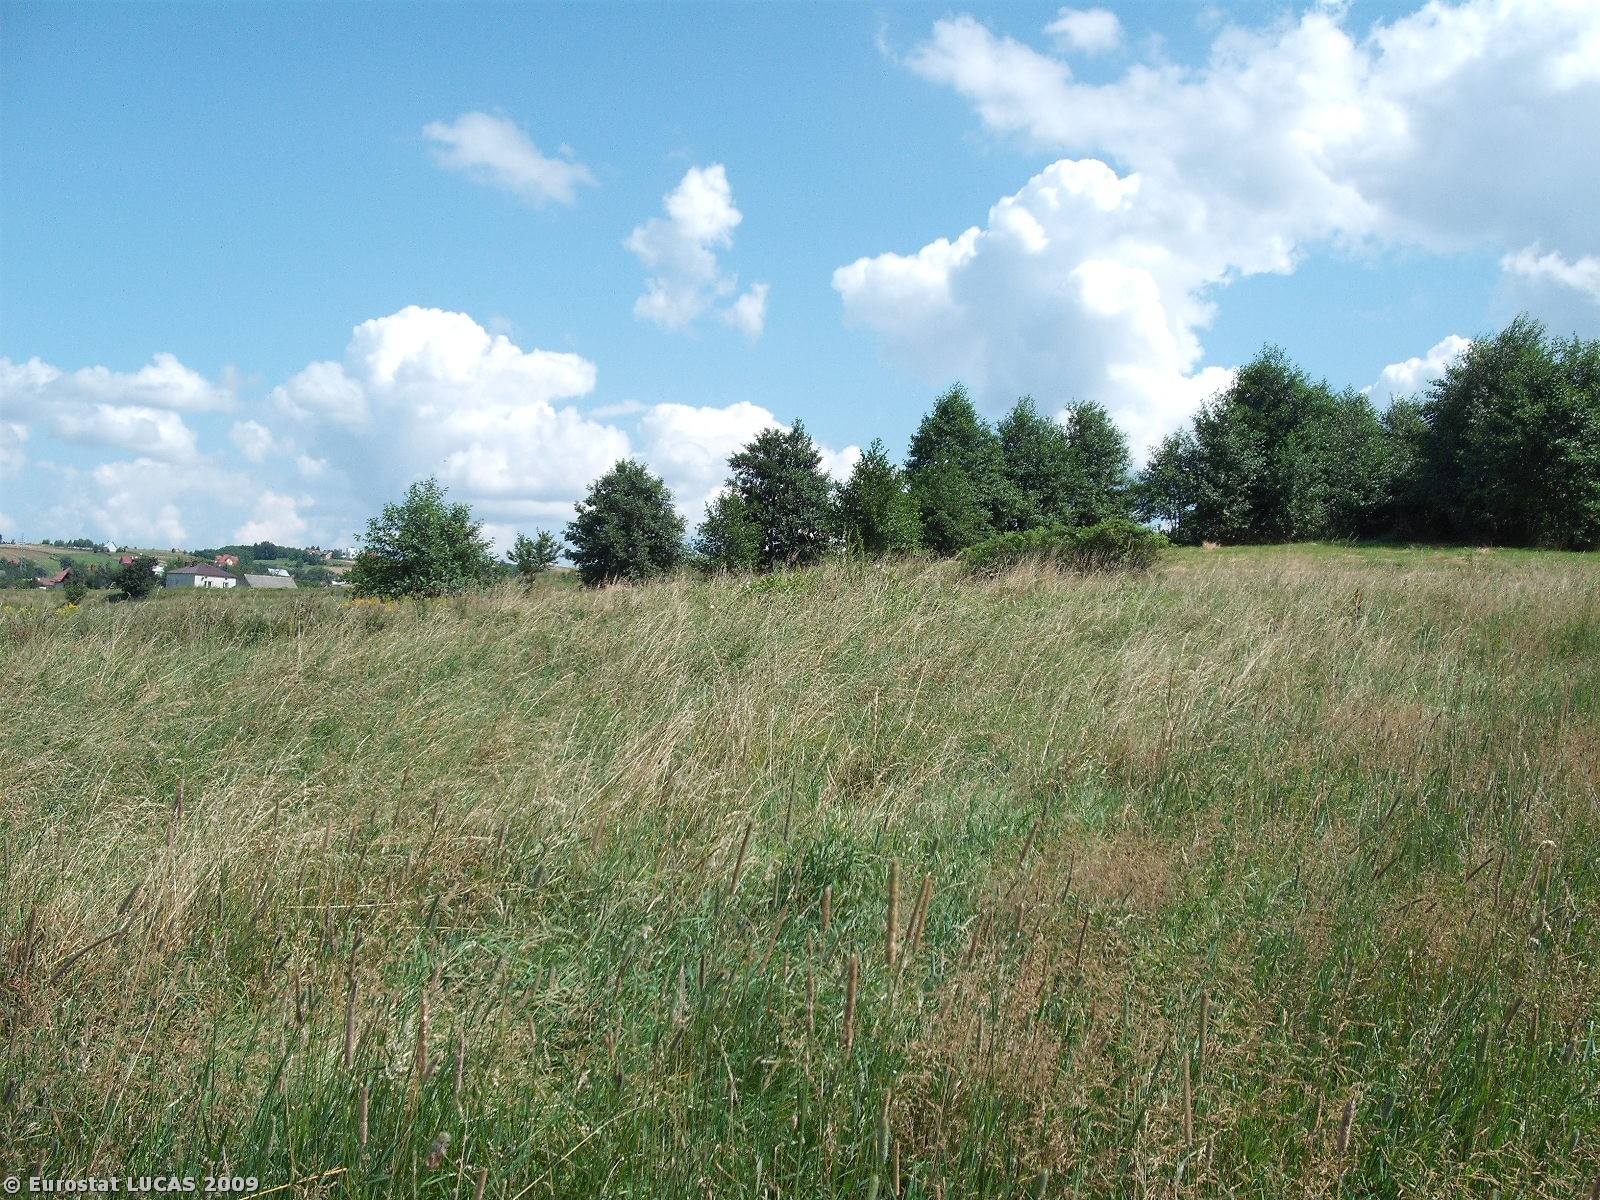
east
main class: Grassland
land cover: Grassland without tree/shrub cover
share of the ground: > 75 %
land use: Agriculture (excluding fallow land and kitchen gardens)
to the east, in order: Grassland without tree/shrub cover; Broadleaved woodland; Common wheat; Grass margins; Potatoes; Grass margins; Bare land; Potatoes; Tracks; Bare land; Tracks; Common wheat; Tracks; Grassland without tree/shrub cover
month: July
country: PL
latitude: 49.9979
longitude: 22.0415
